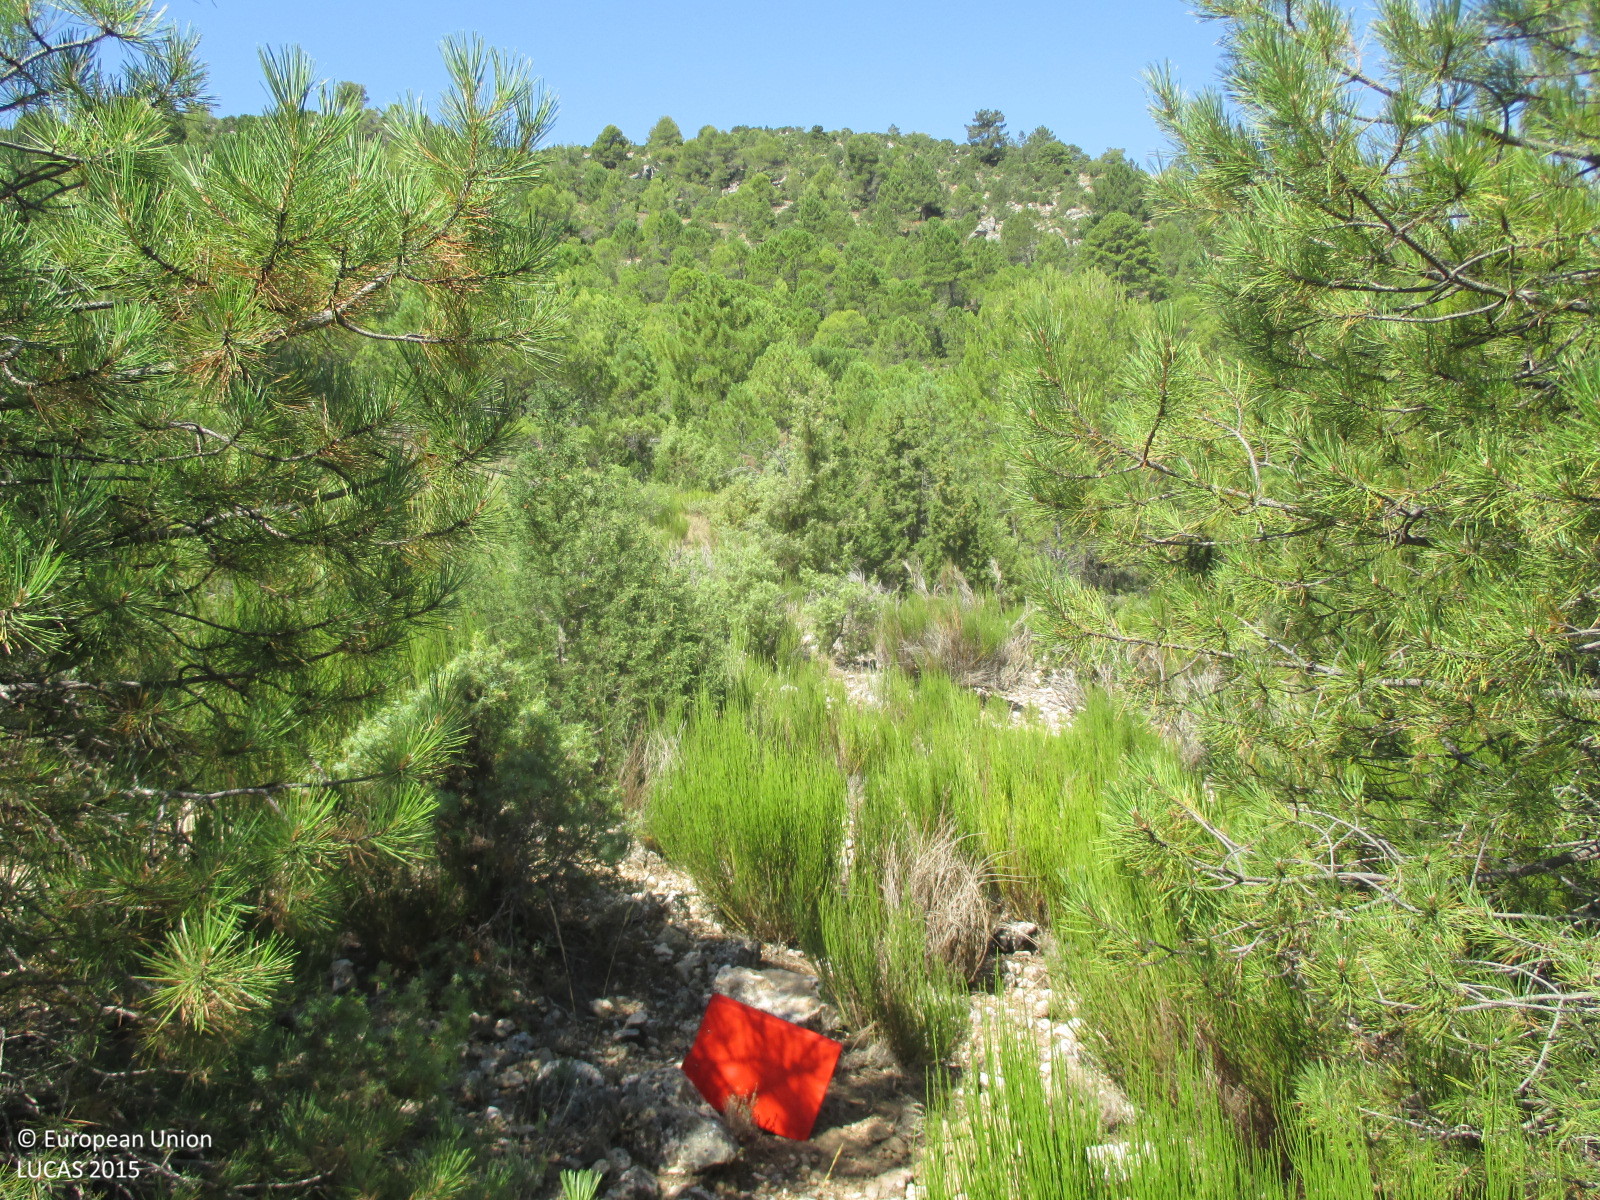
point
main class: Woodland
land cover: Pine dominated coniferous woodland
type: coniferous forest of the mediterranean region
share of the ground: 25 - 50 %
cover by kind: coniferous forest trees 40 %, shrubs 40 %, herbaceous plants 20 %
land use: Forestry
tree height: > 5 m
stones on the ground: < 10 %
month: July
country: ES
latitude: 38.2761
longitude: -2.3518
